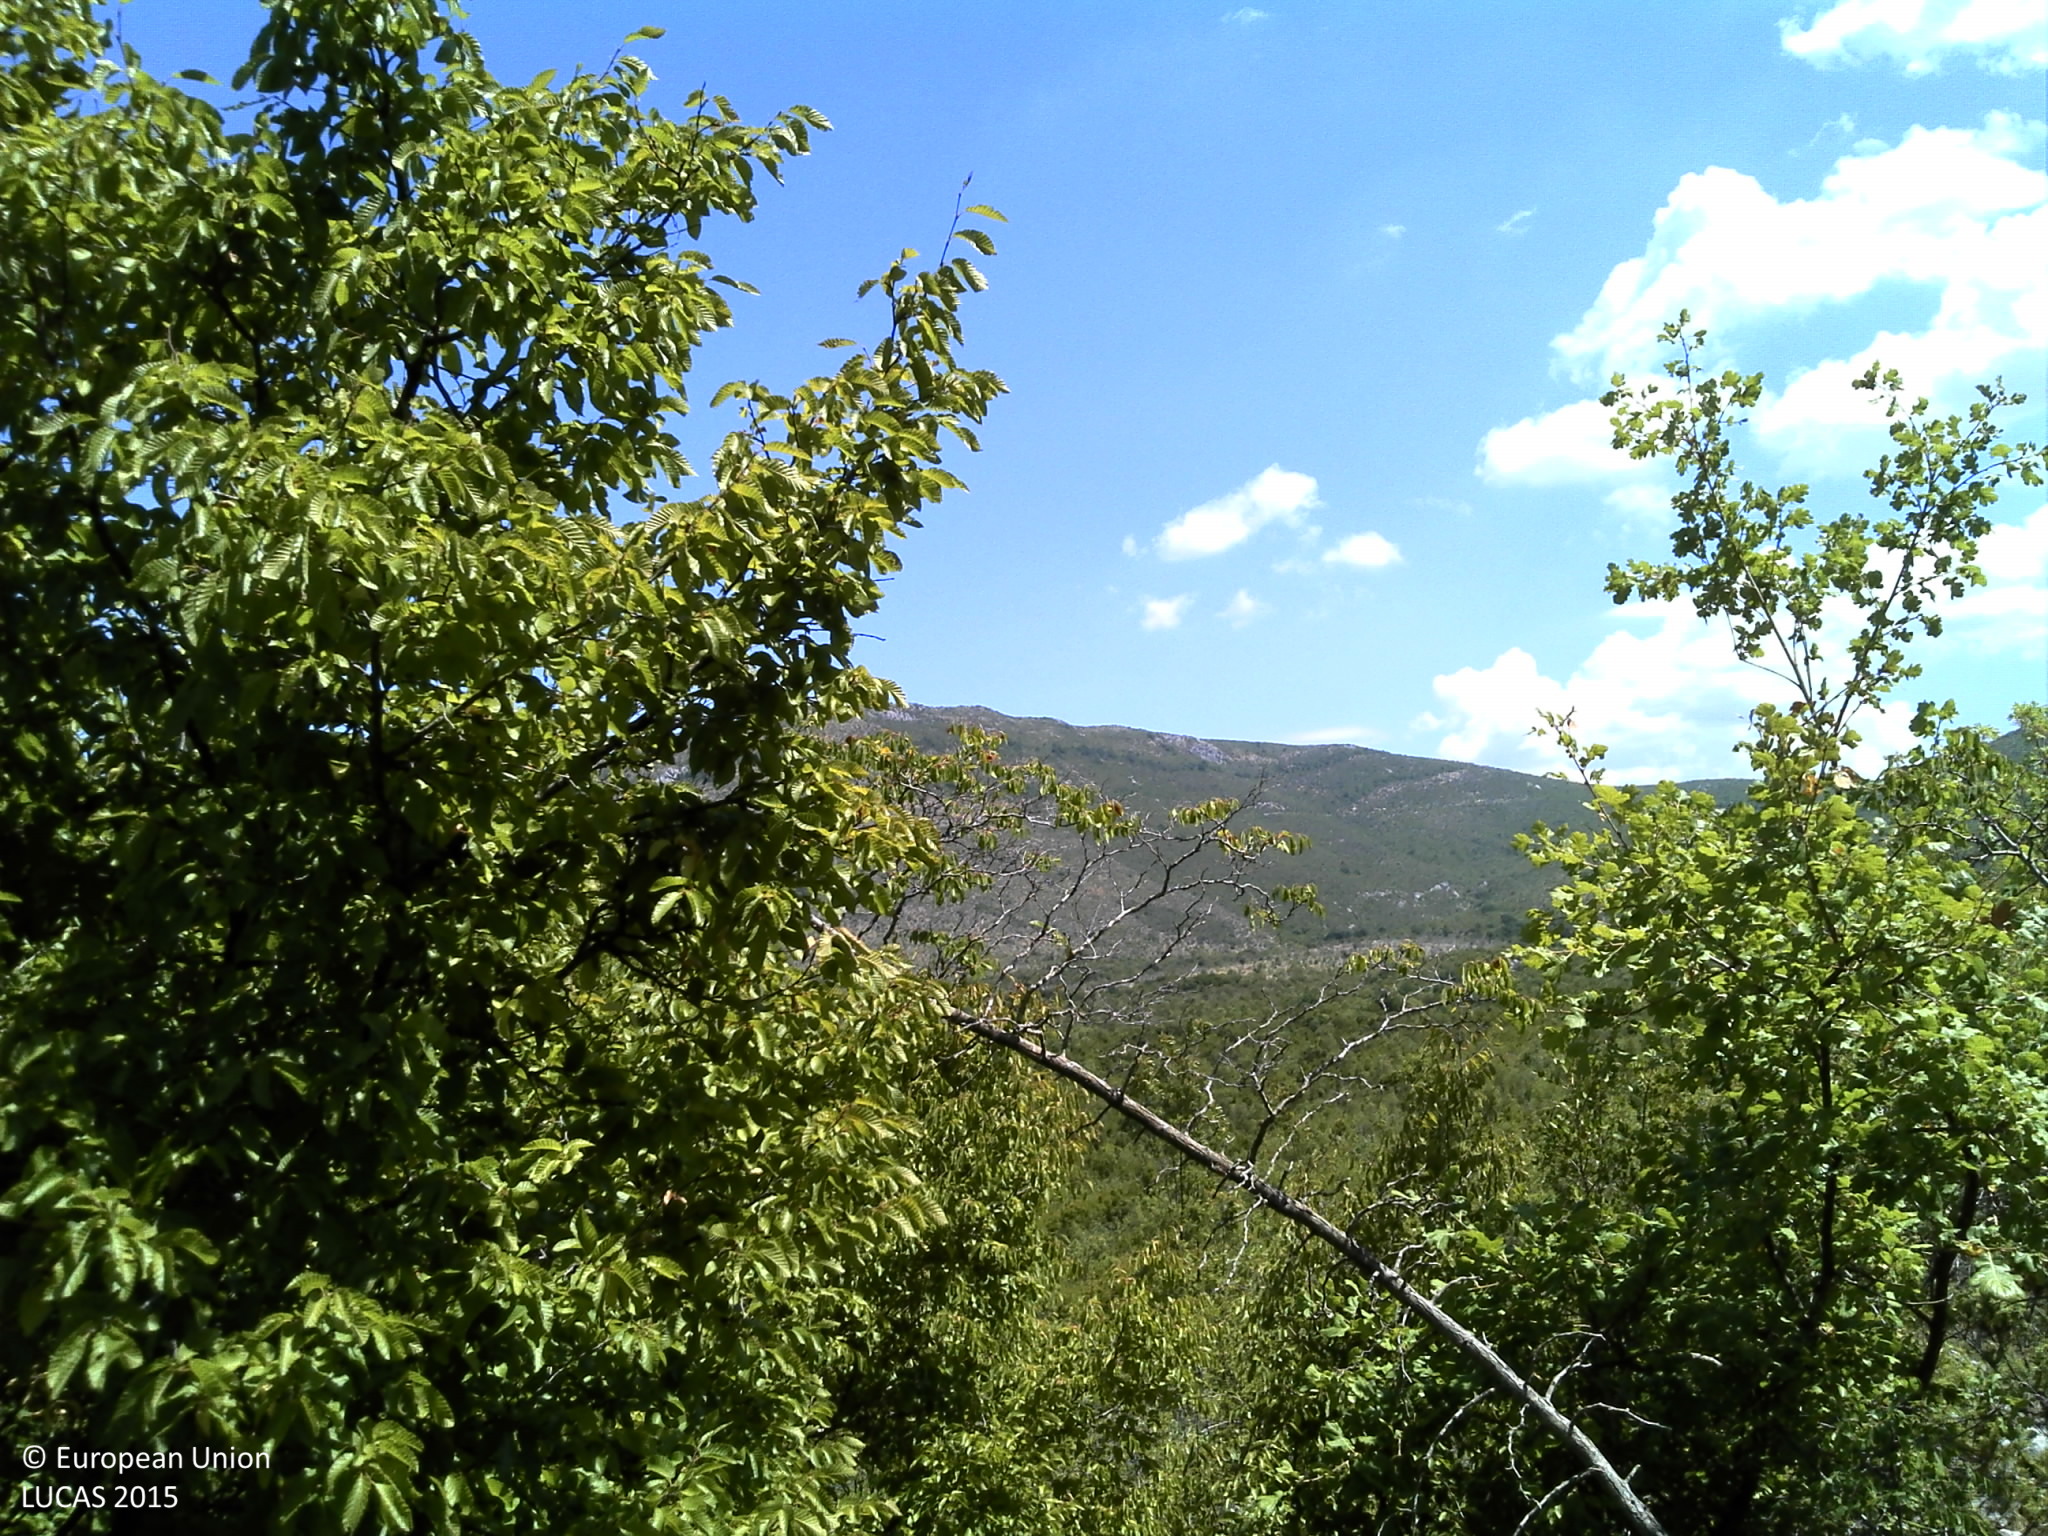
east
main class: Woodland
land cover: Other mixed woodland
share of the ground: > 75 %
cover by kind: broadleaved forest trees 30 %, unconsolidated bare surface 30 %, shrubs 25 %, coniferous forest trees 15 %
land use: Semi-natural and natural areas not in use
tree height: < 5 m
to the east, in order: Other mixed woodland; Dry stone walls; Other mixed woodland
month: July
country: HR
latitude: 43.0145
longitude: 17.6840
